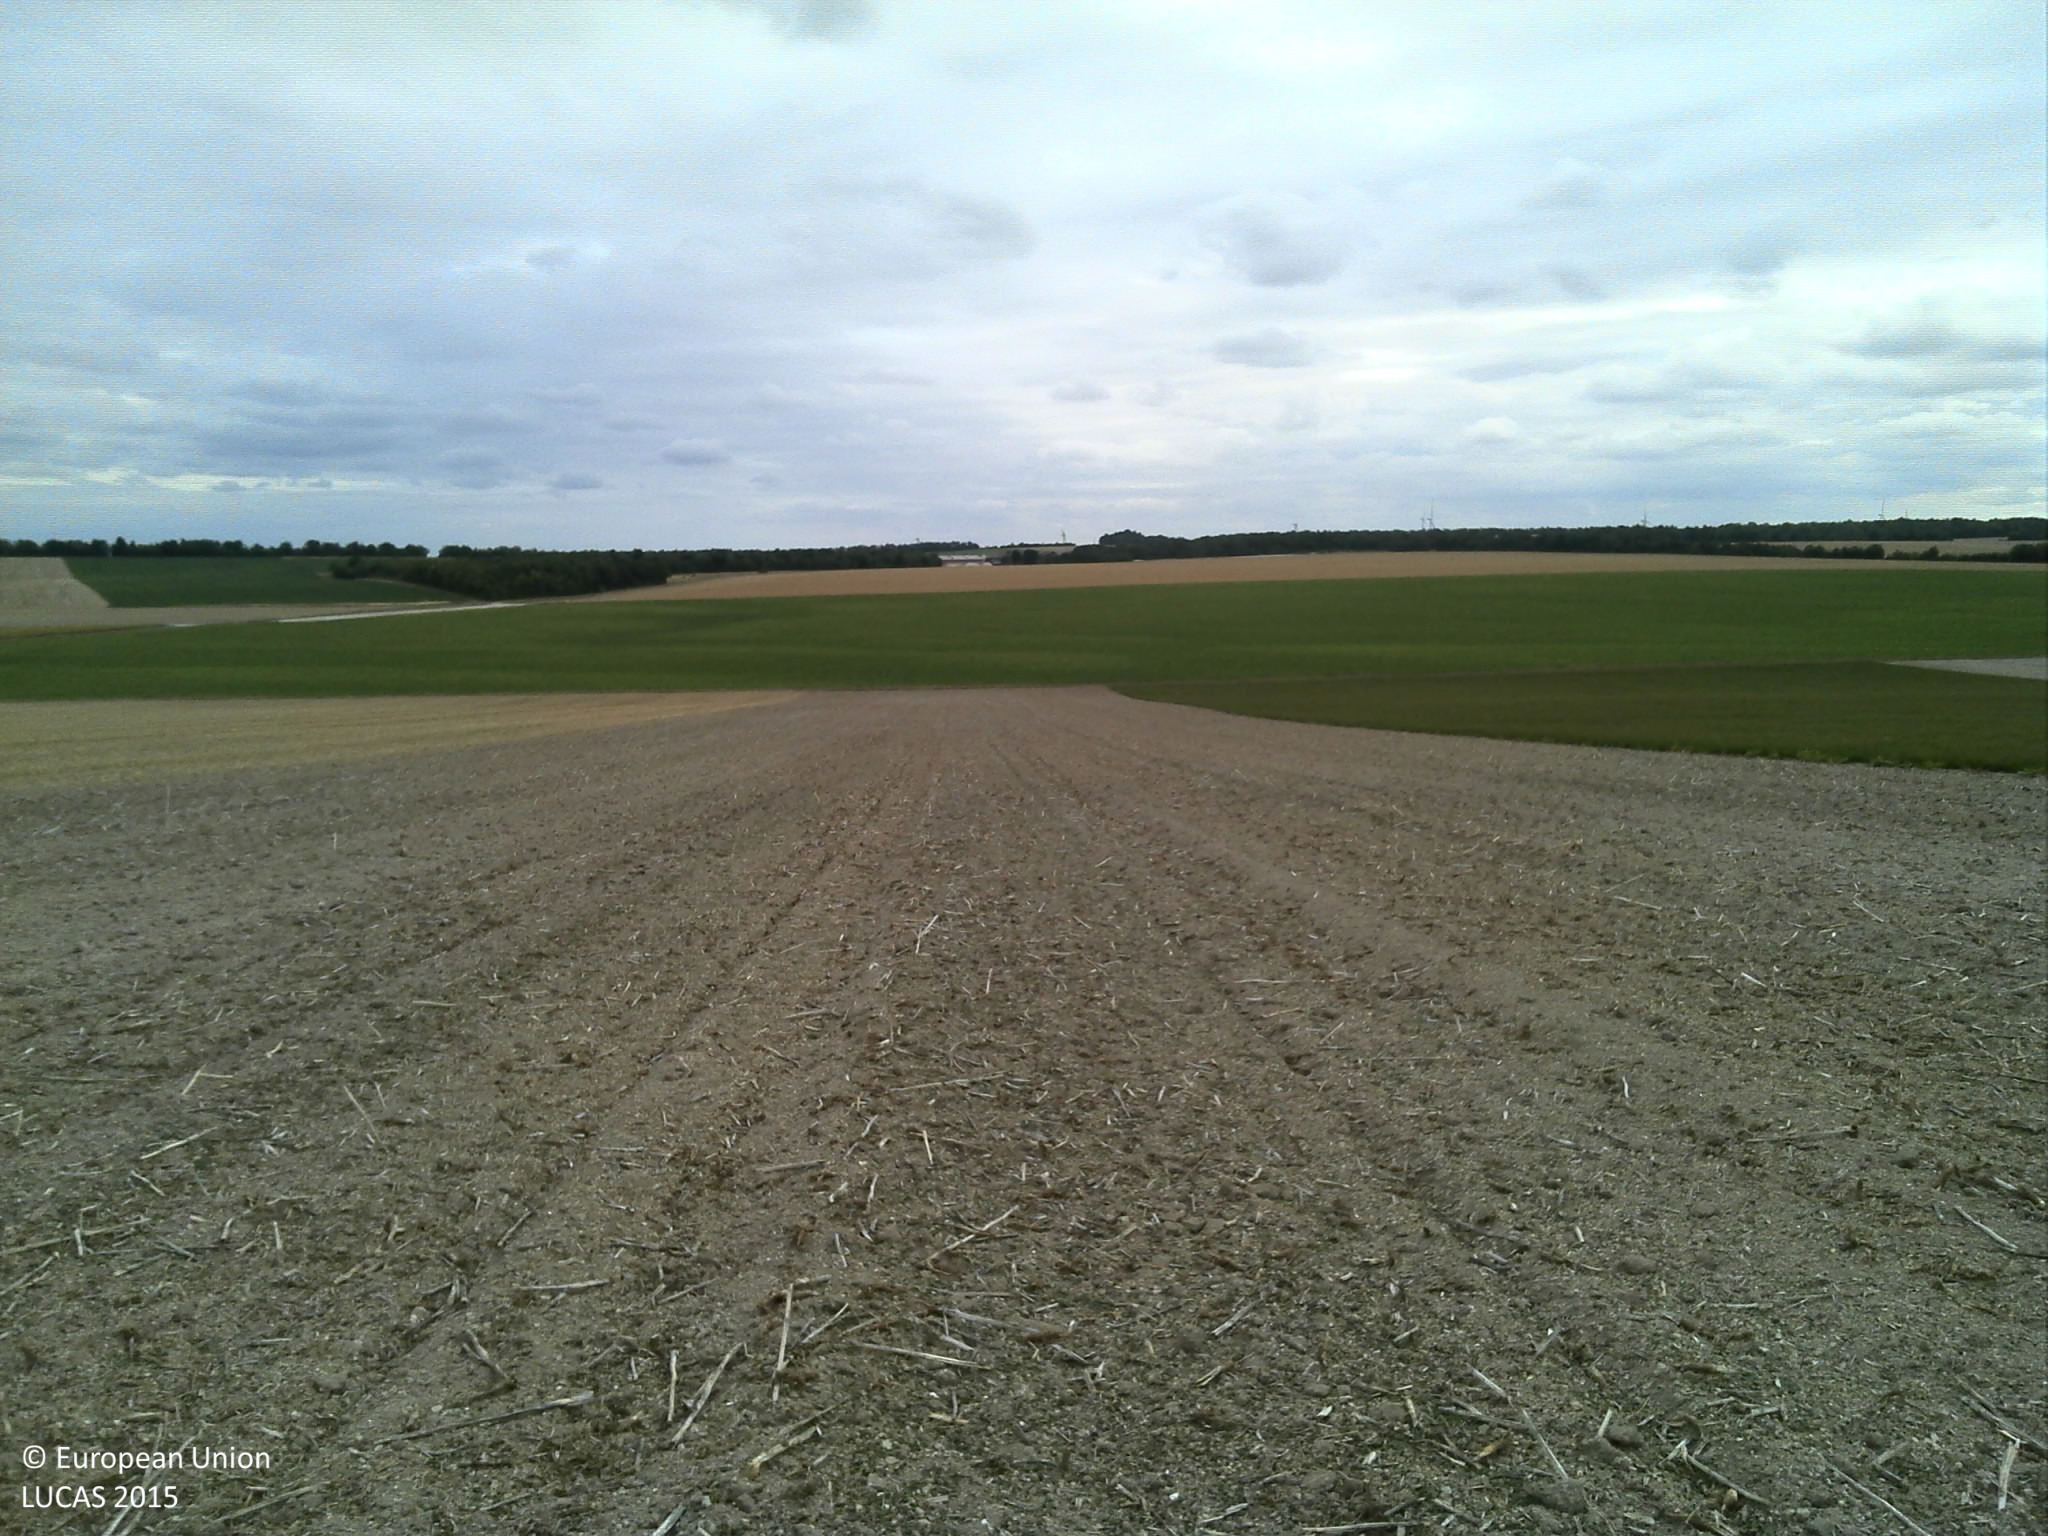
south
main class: Cropland
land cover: Rape and turnip rape
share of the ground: < 10 %
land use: Agriculture (excluding fallow land and kitchen gardens)
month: August
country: FR
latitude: 48.4853
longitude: 4.1921
